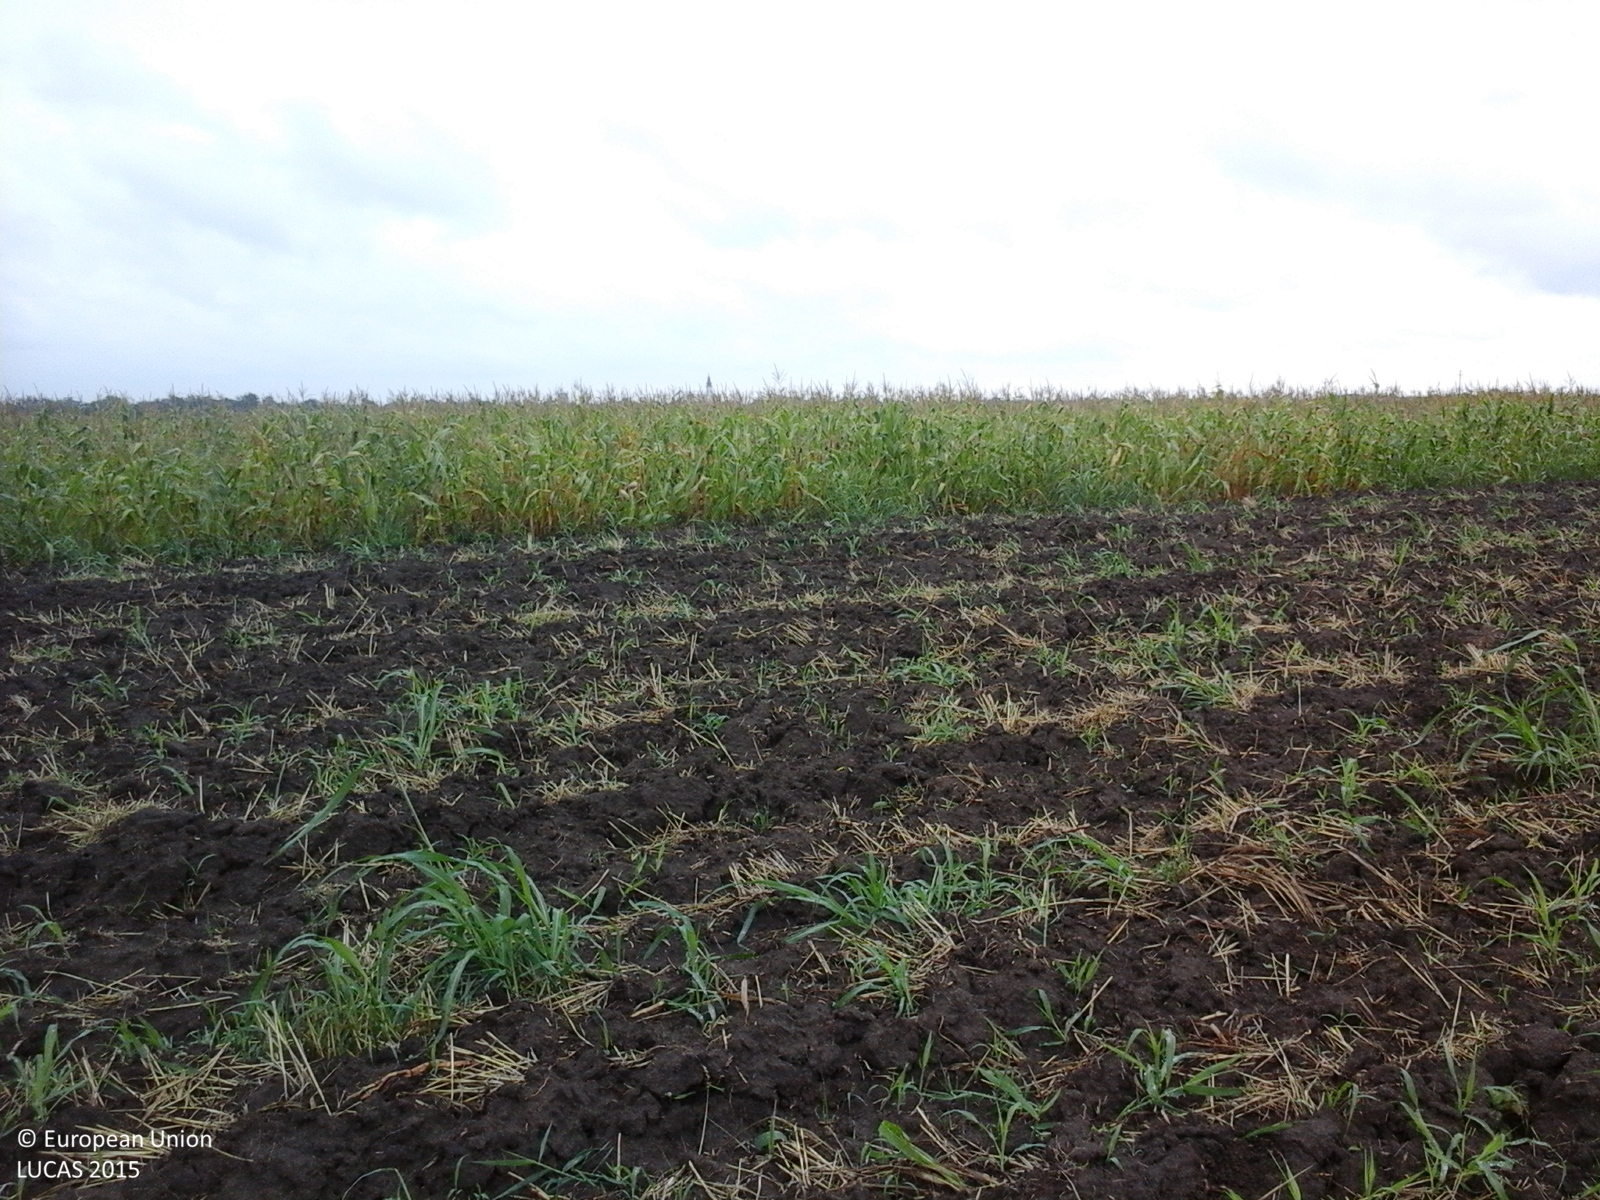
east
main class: Cropland
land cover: Common wheat
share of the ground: < 10 %
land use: Agriculture (excluding fallow land and kitchen gardens)
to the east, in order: Common wheat; Maize; Common wheat; Maize
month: August
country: RO
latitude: 46.0375
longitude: 20.4512
